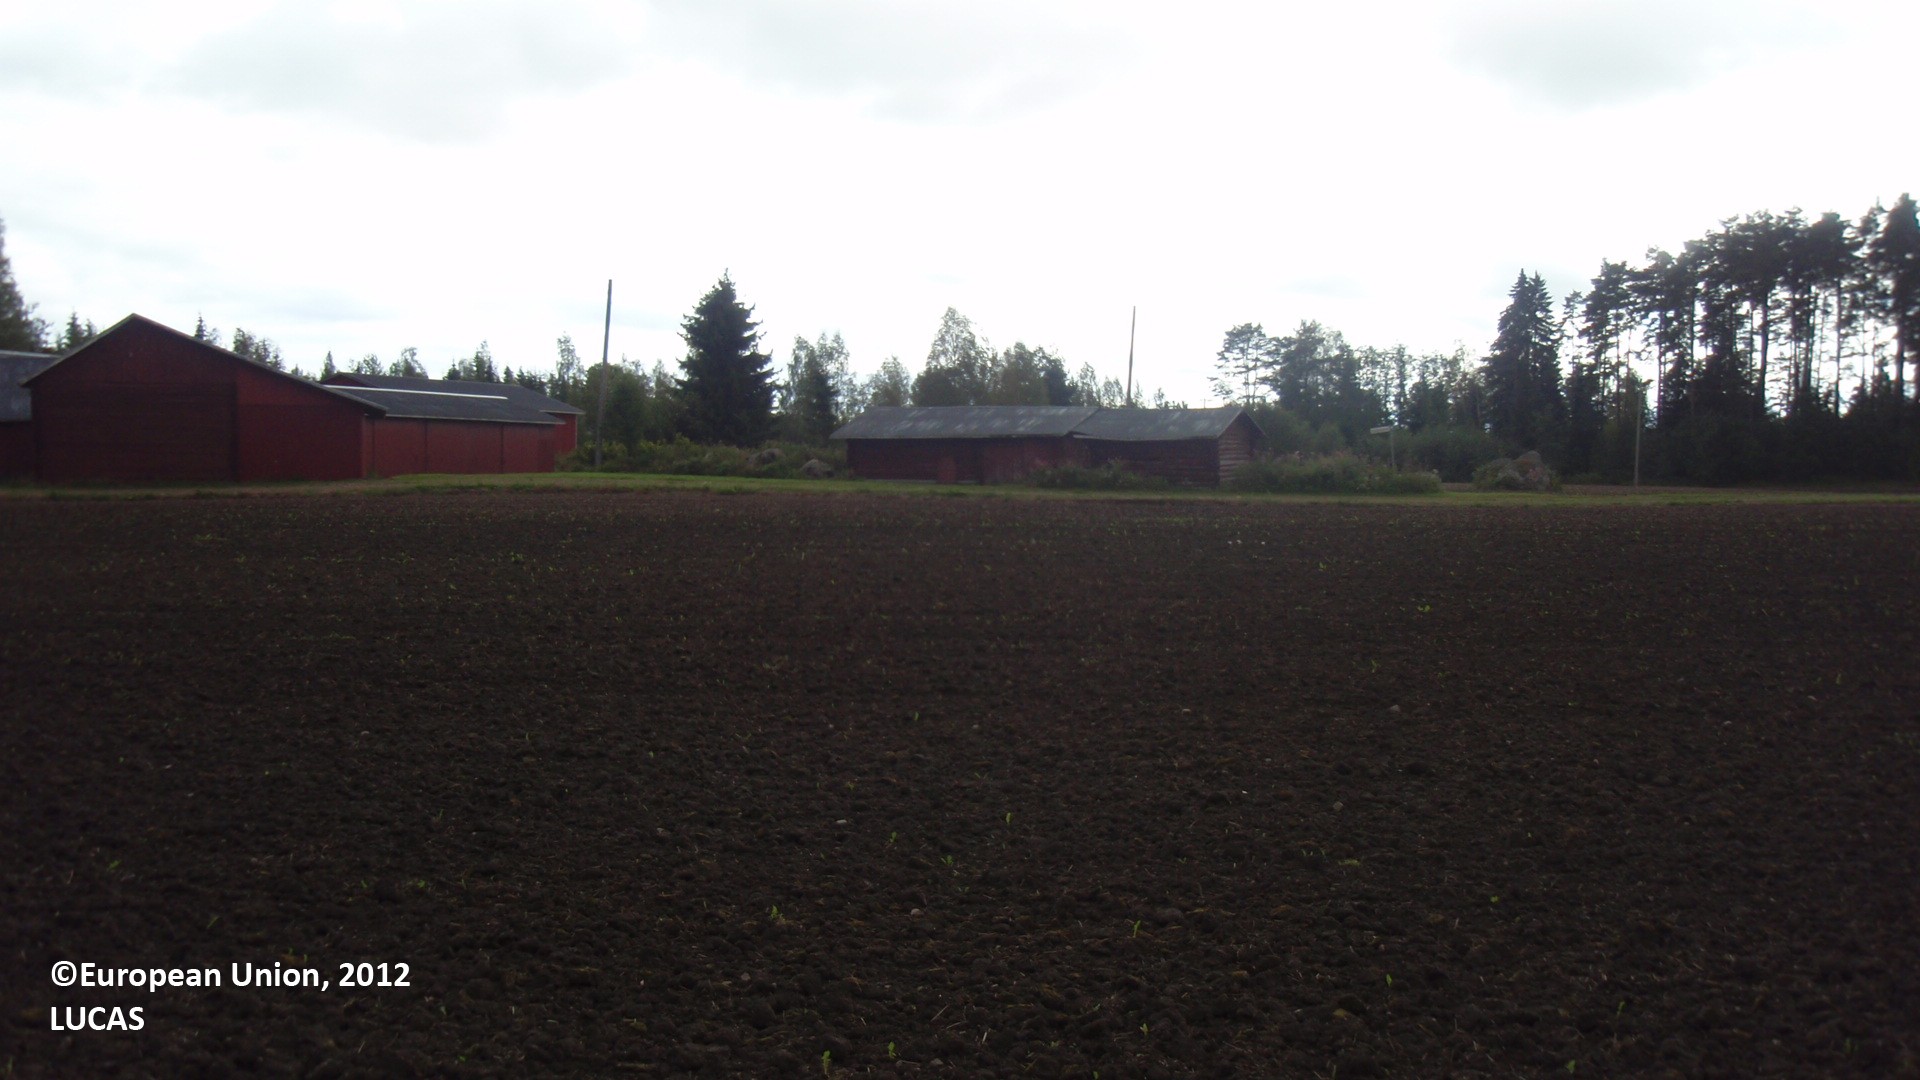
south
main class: Cropland
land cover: Oats
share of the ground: > 75 %
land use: Agriculture (excluding fallow land and kitchen gardens)
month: August
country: FI
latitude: 61.0115
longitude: 27.0946
